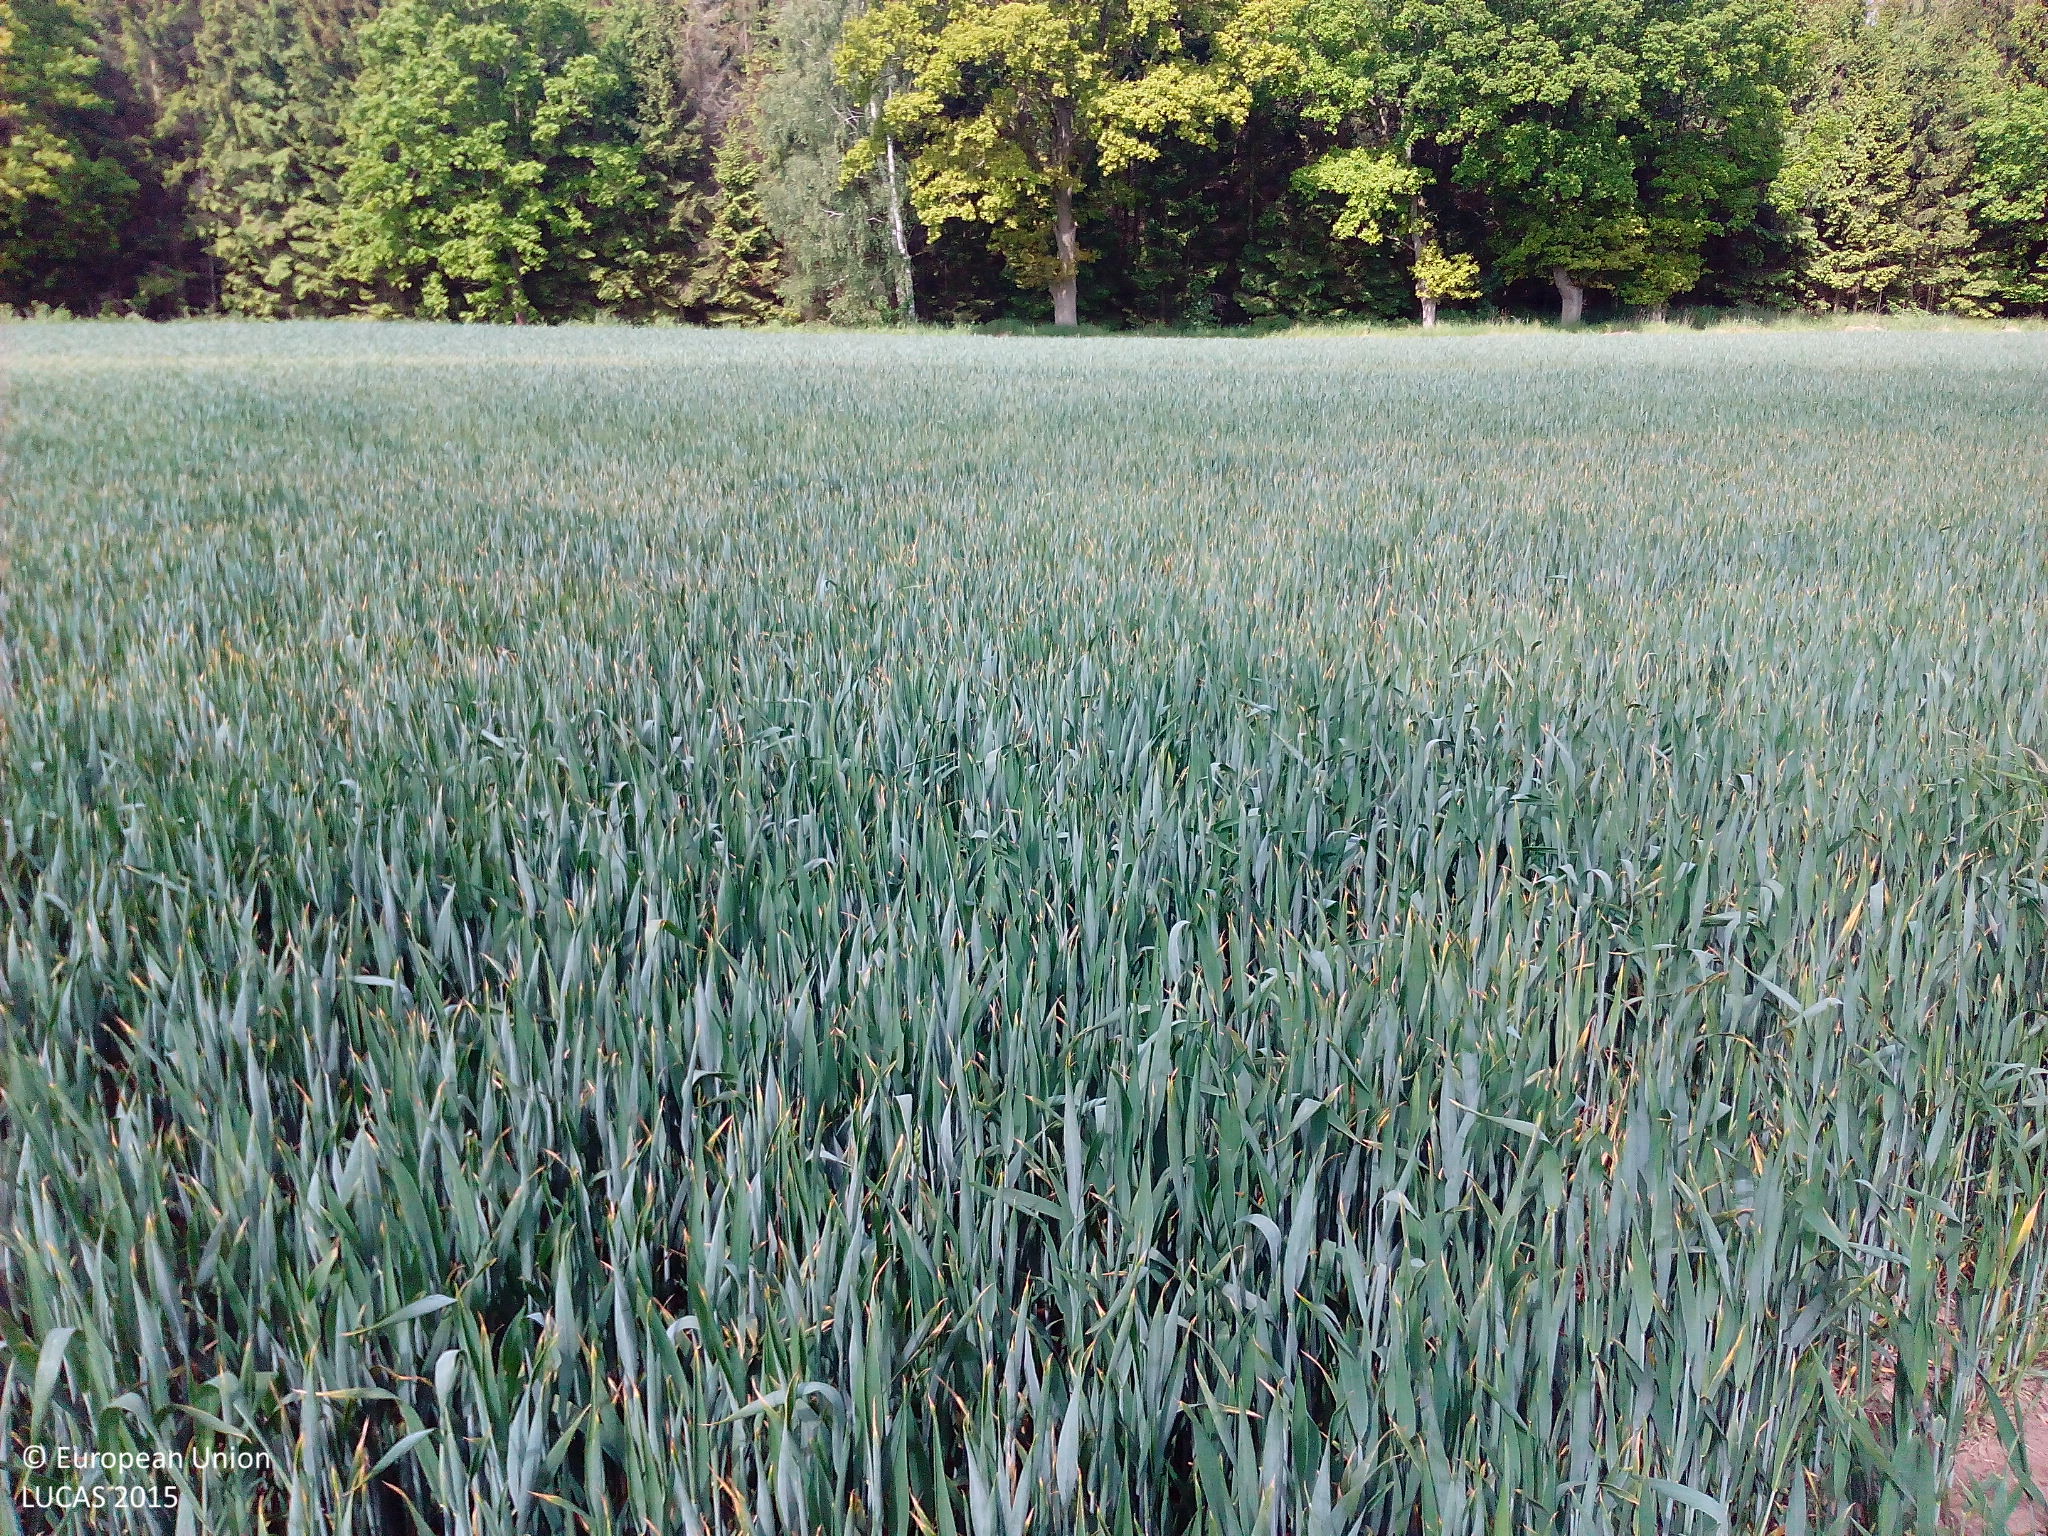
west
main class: Cropland
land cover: Rye
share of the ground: > 75 %
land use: Agriculture (excluding fallow land and kitchen gardens)
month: June
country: DE
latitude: 54.4180
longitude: 13.3124
